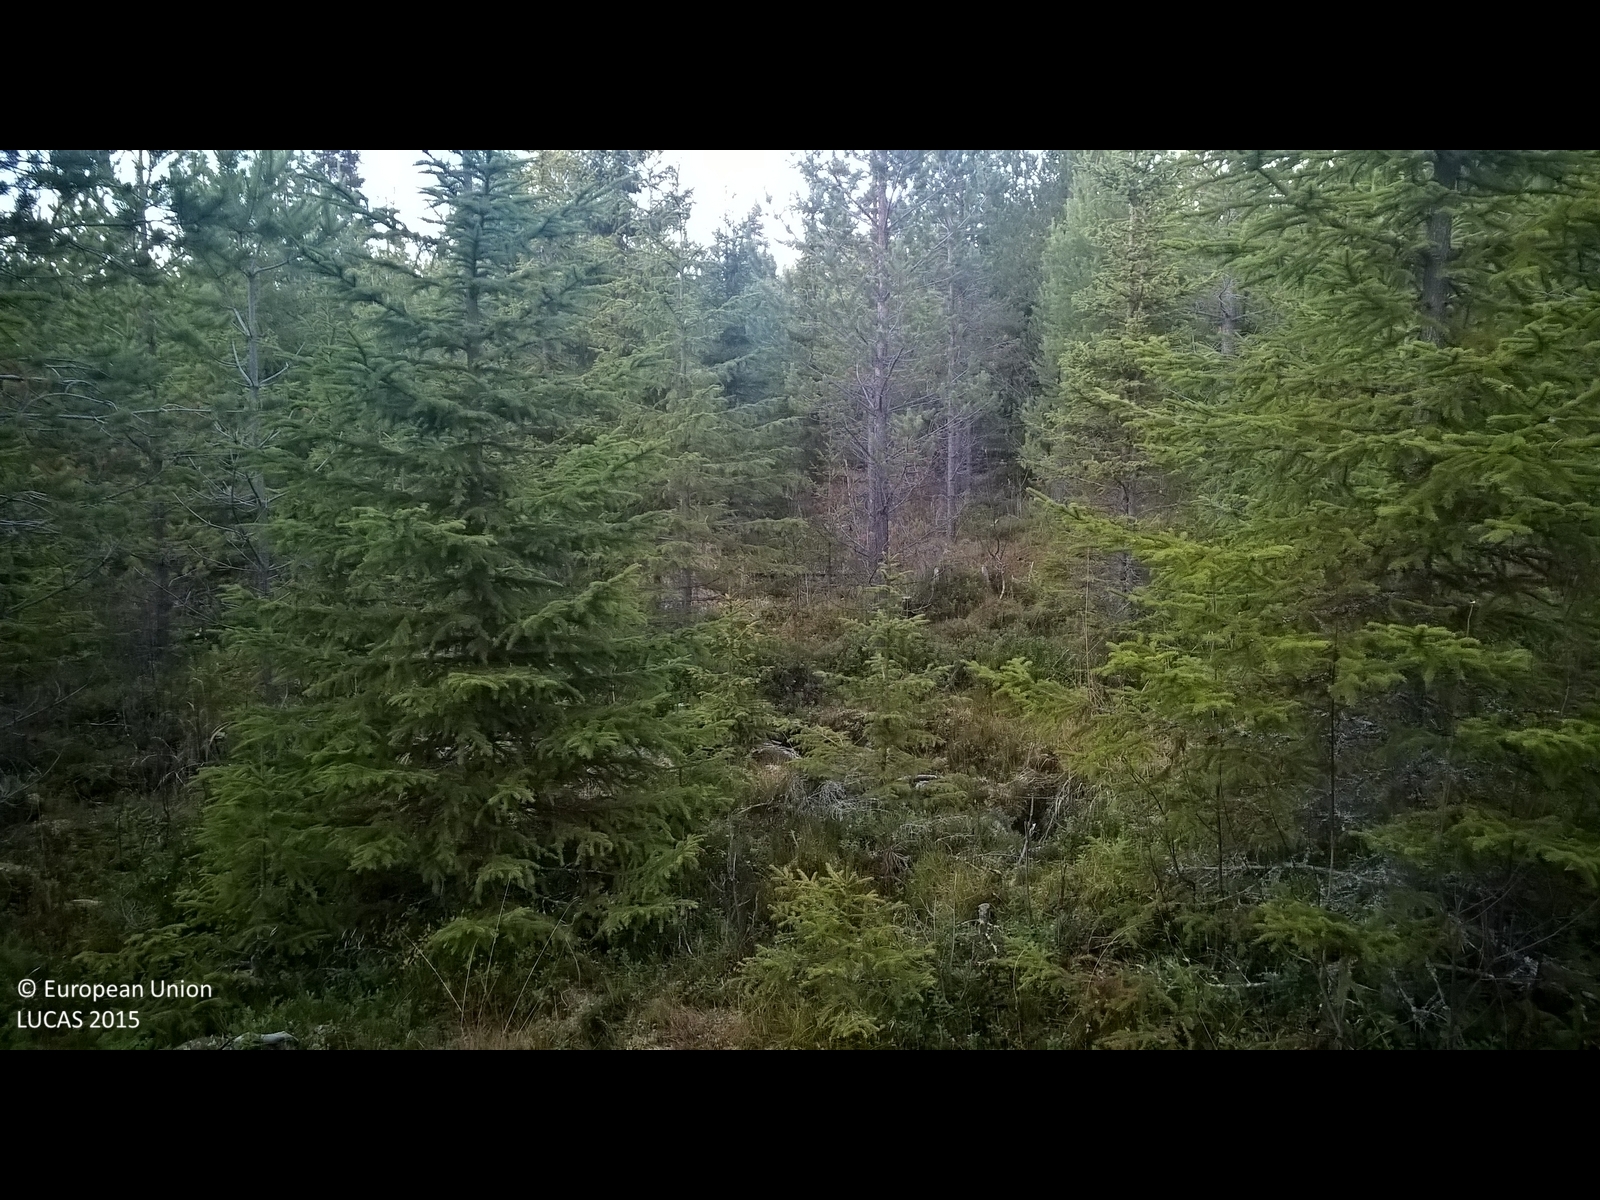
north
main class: Woodland
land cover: Spruce dominated coniferous woodland
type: boreal forest
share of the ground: 50 - 75 %
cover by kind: coniferous forest trees 70 %, lichens and mosses 30 %
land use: Forestry
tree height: > 5 m
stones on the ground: < 10 %
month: October
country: SE
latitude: 62.9575
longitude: 15.6751
